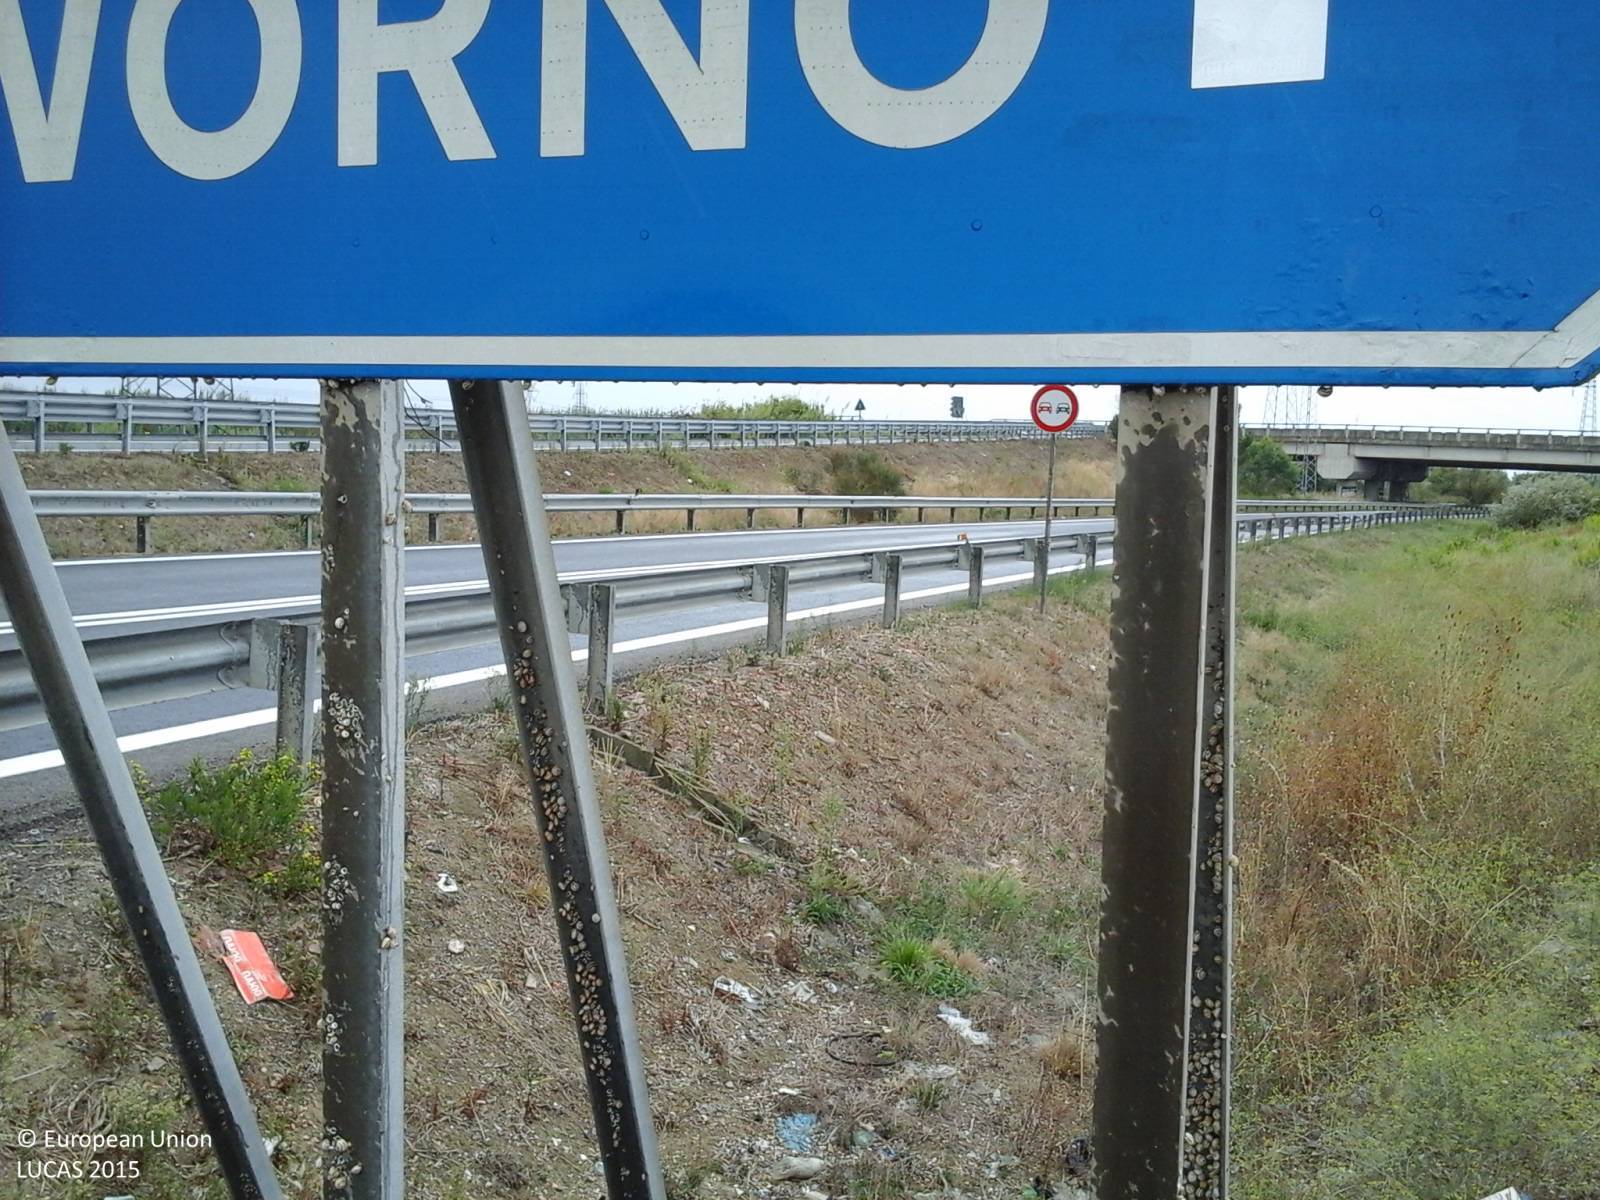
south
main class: Grassland
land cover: Grassland without tree/shrub cover
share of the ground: > 75 %
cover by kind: herbaceous plants 100 %
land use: Road transport
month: October
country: IT
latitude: 43.0134
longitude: 10.5993
